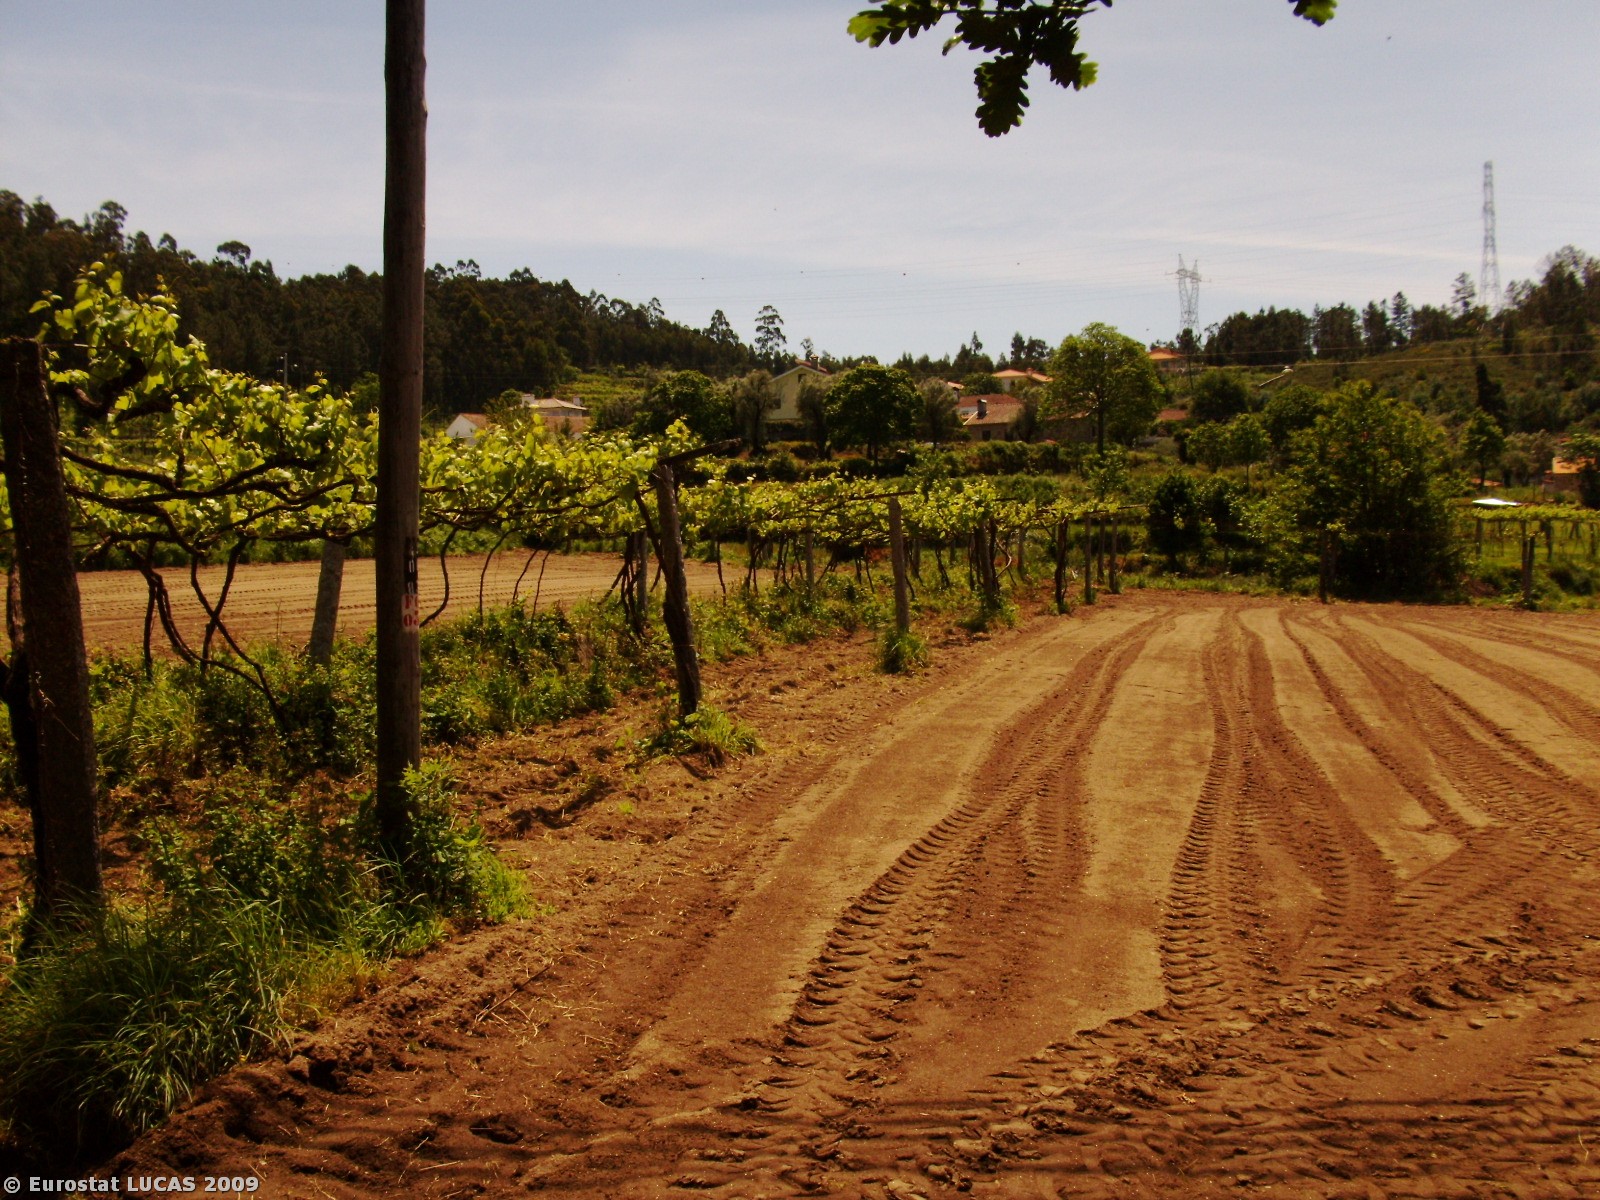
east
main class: Shrubland
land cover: Shrubland with sparse tree cover
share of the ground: > 75 %
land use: Fallow land
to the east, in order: Shrubland with sparse tree cover; Vineyards; Bare land; Grass margins; Rivers and streams; Shrubland with sparse tree cover; Vineyards; Spontaneously vegetated surfaces; Vineyards; Spontaneously vegetated surfaces; Vineyards; Artificial constructions in urban areas
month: May
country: PT
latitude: 41.6494
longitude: -8.6162
